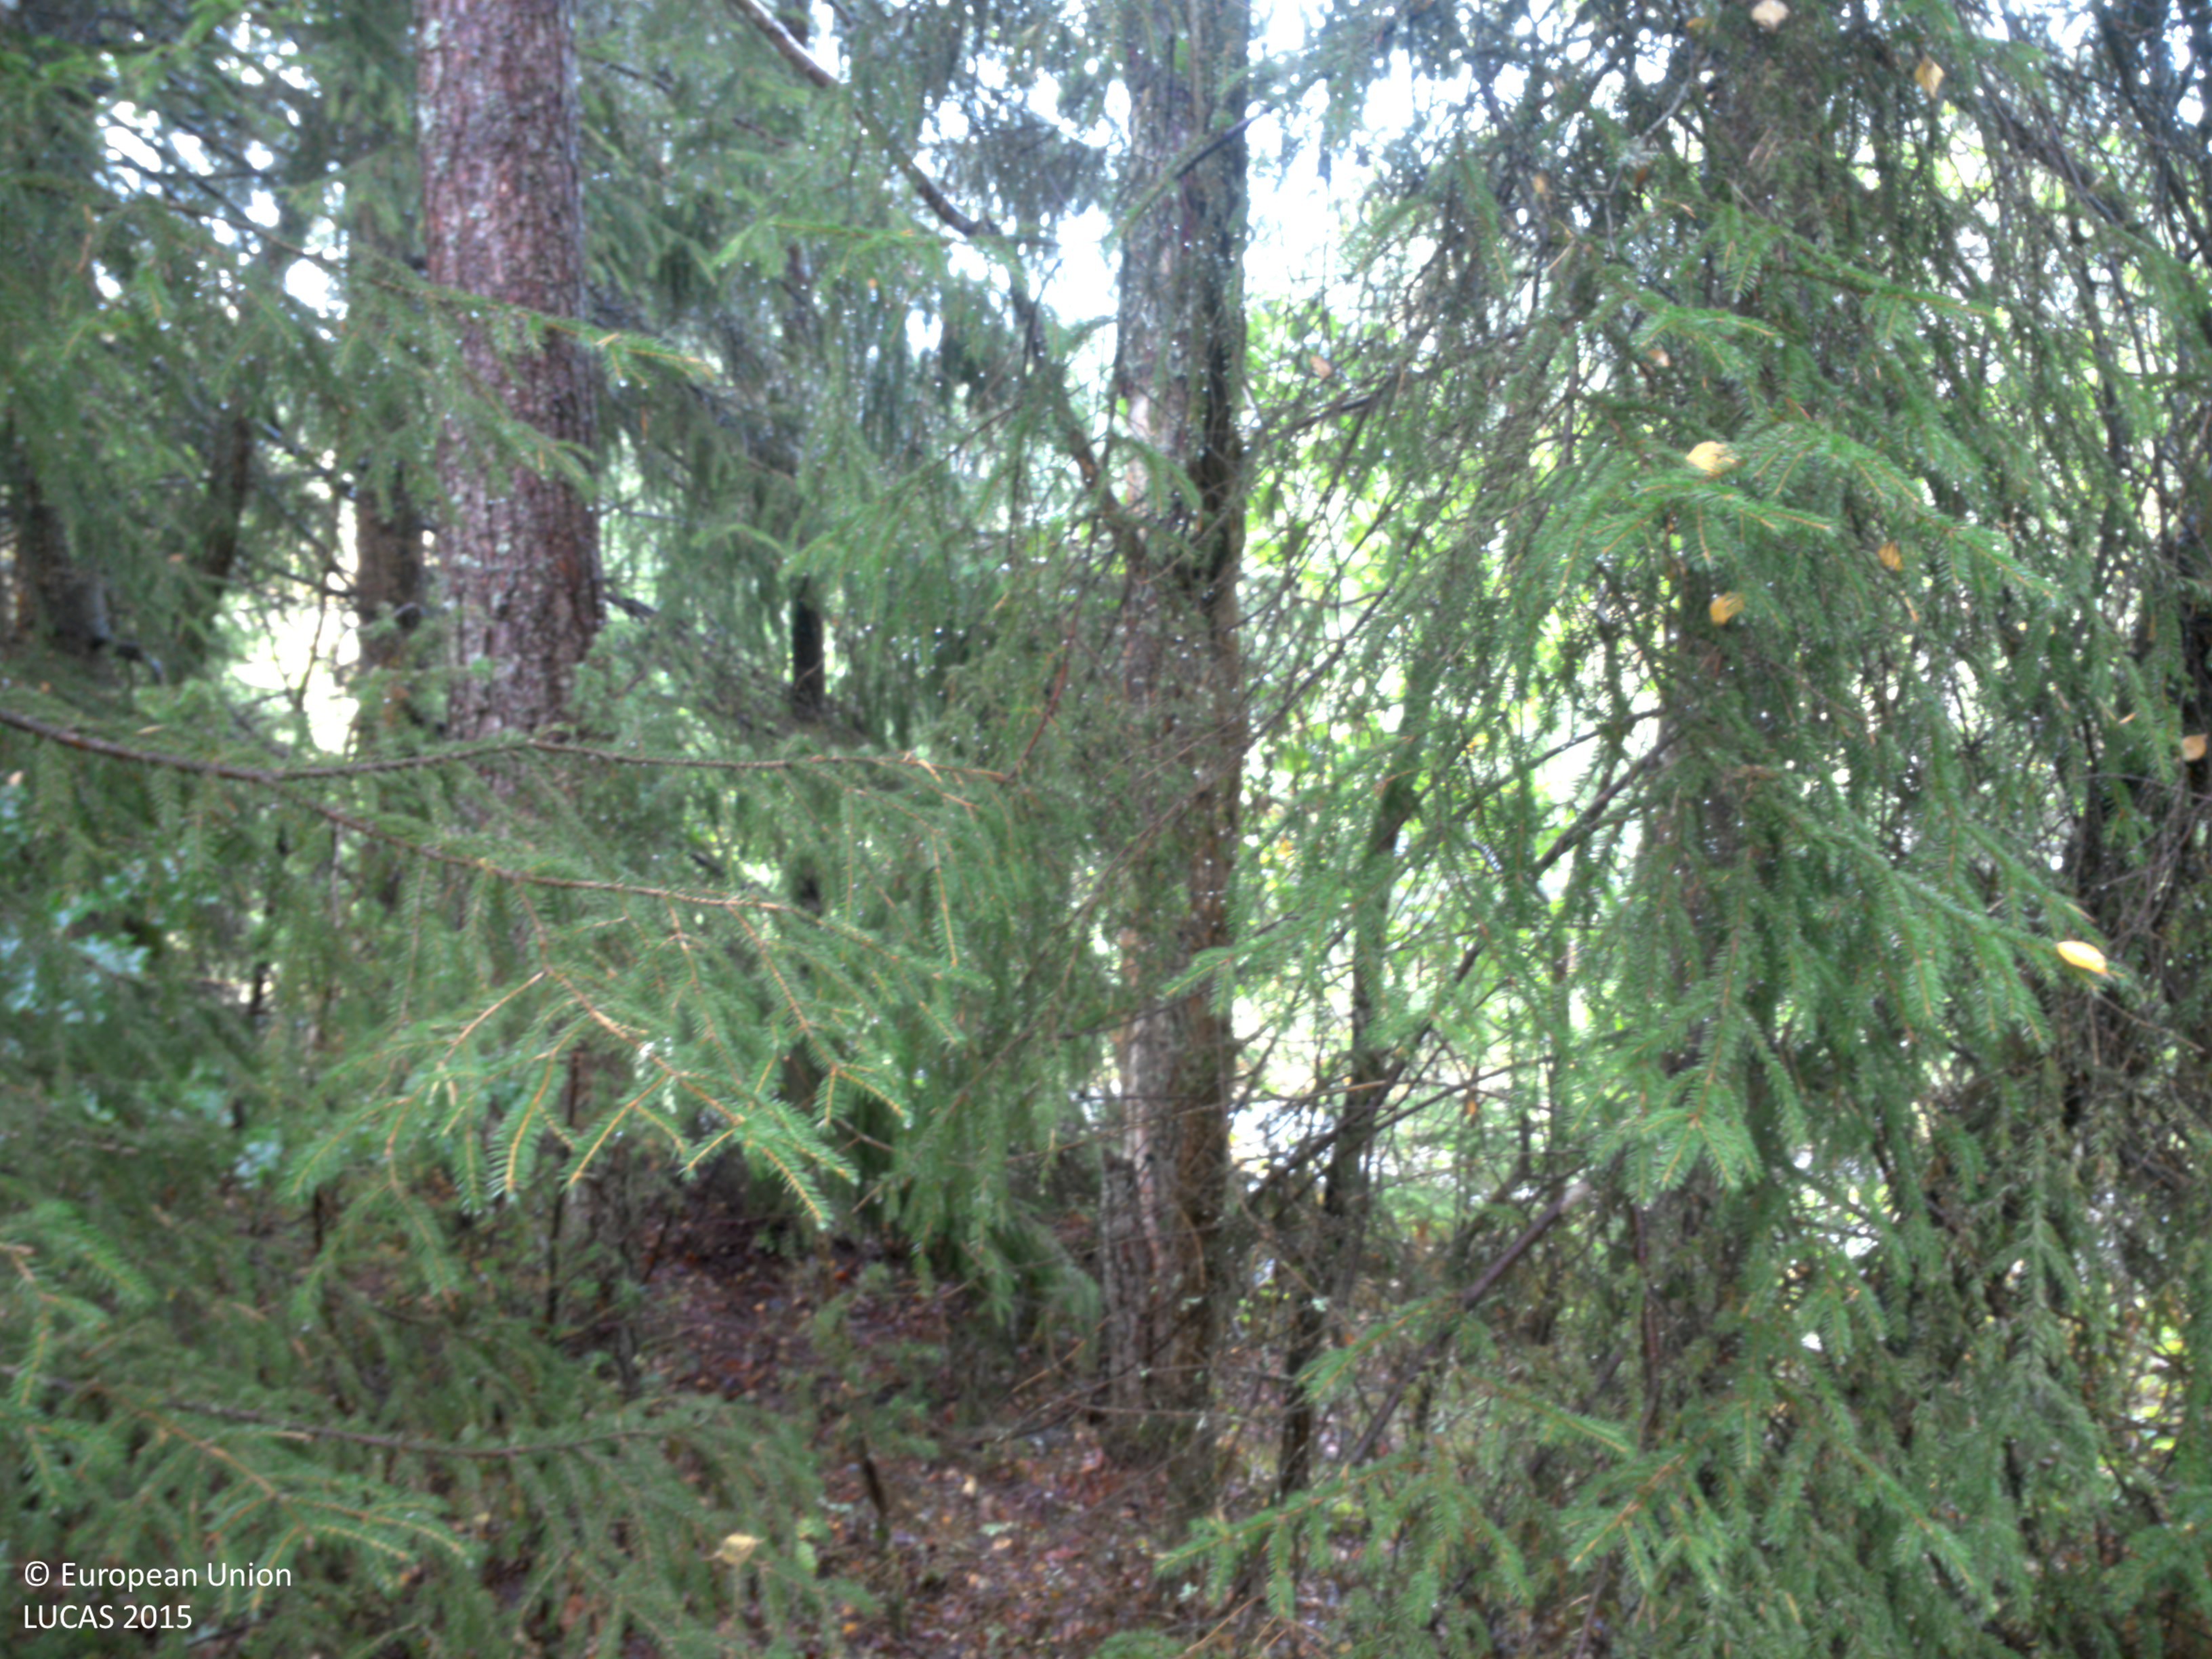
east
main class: Woodland
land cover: Other mixed woodland
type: boreal forest
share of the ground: 50 - 75 %
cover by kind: coniferous forest trees 30 %, broadleaved forest trees 30 %, herbaceous plants 30 %, lichens and mosses 10 %
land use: Forestry
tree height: > 5 m
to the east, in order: Other mixed woodland; Paved roads, cycling and walking lanes; Grass margins; Fences; Broadleaved woodland; Grassland without tree/shrub cover; Ditches and canals; Grassland without tree/shrub cover; Fences; Grassland without tree/shrub cover; Ditches and canals; Grassland without tree/shrub cover; Fences; Broadleaved woodland; Dry stone walls; Fences; Broadleaved woodland
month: August
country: SE
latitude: 58.1634
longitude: 12.3243
